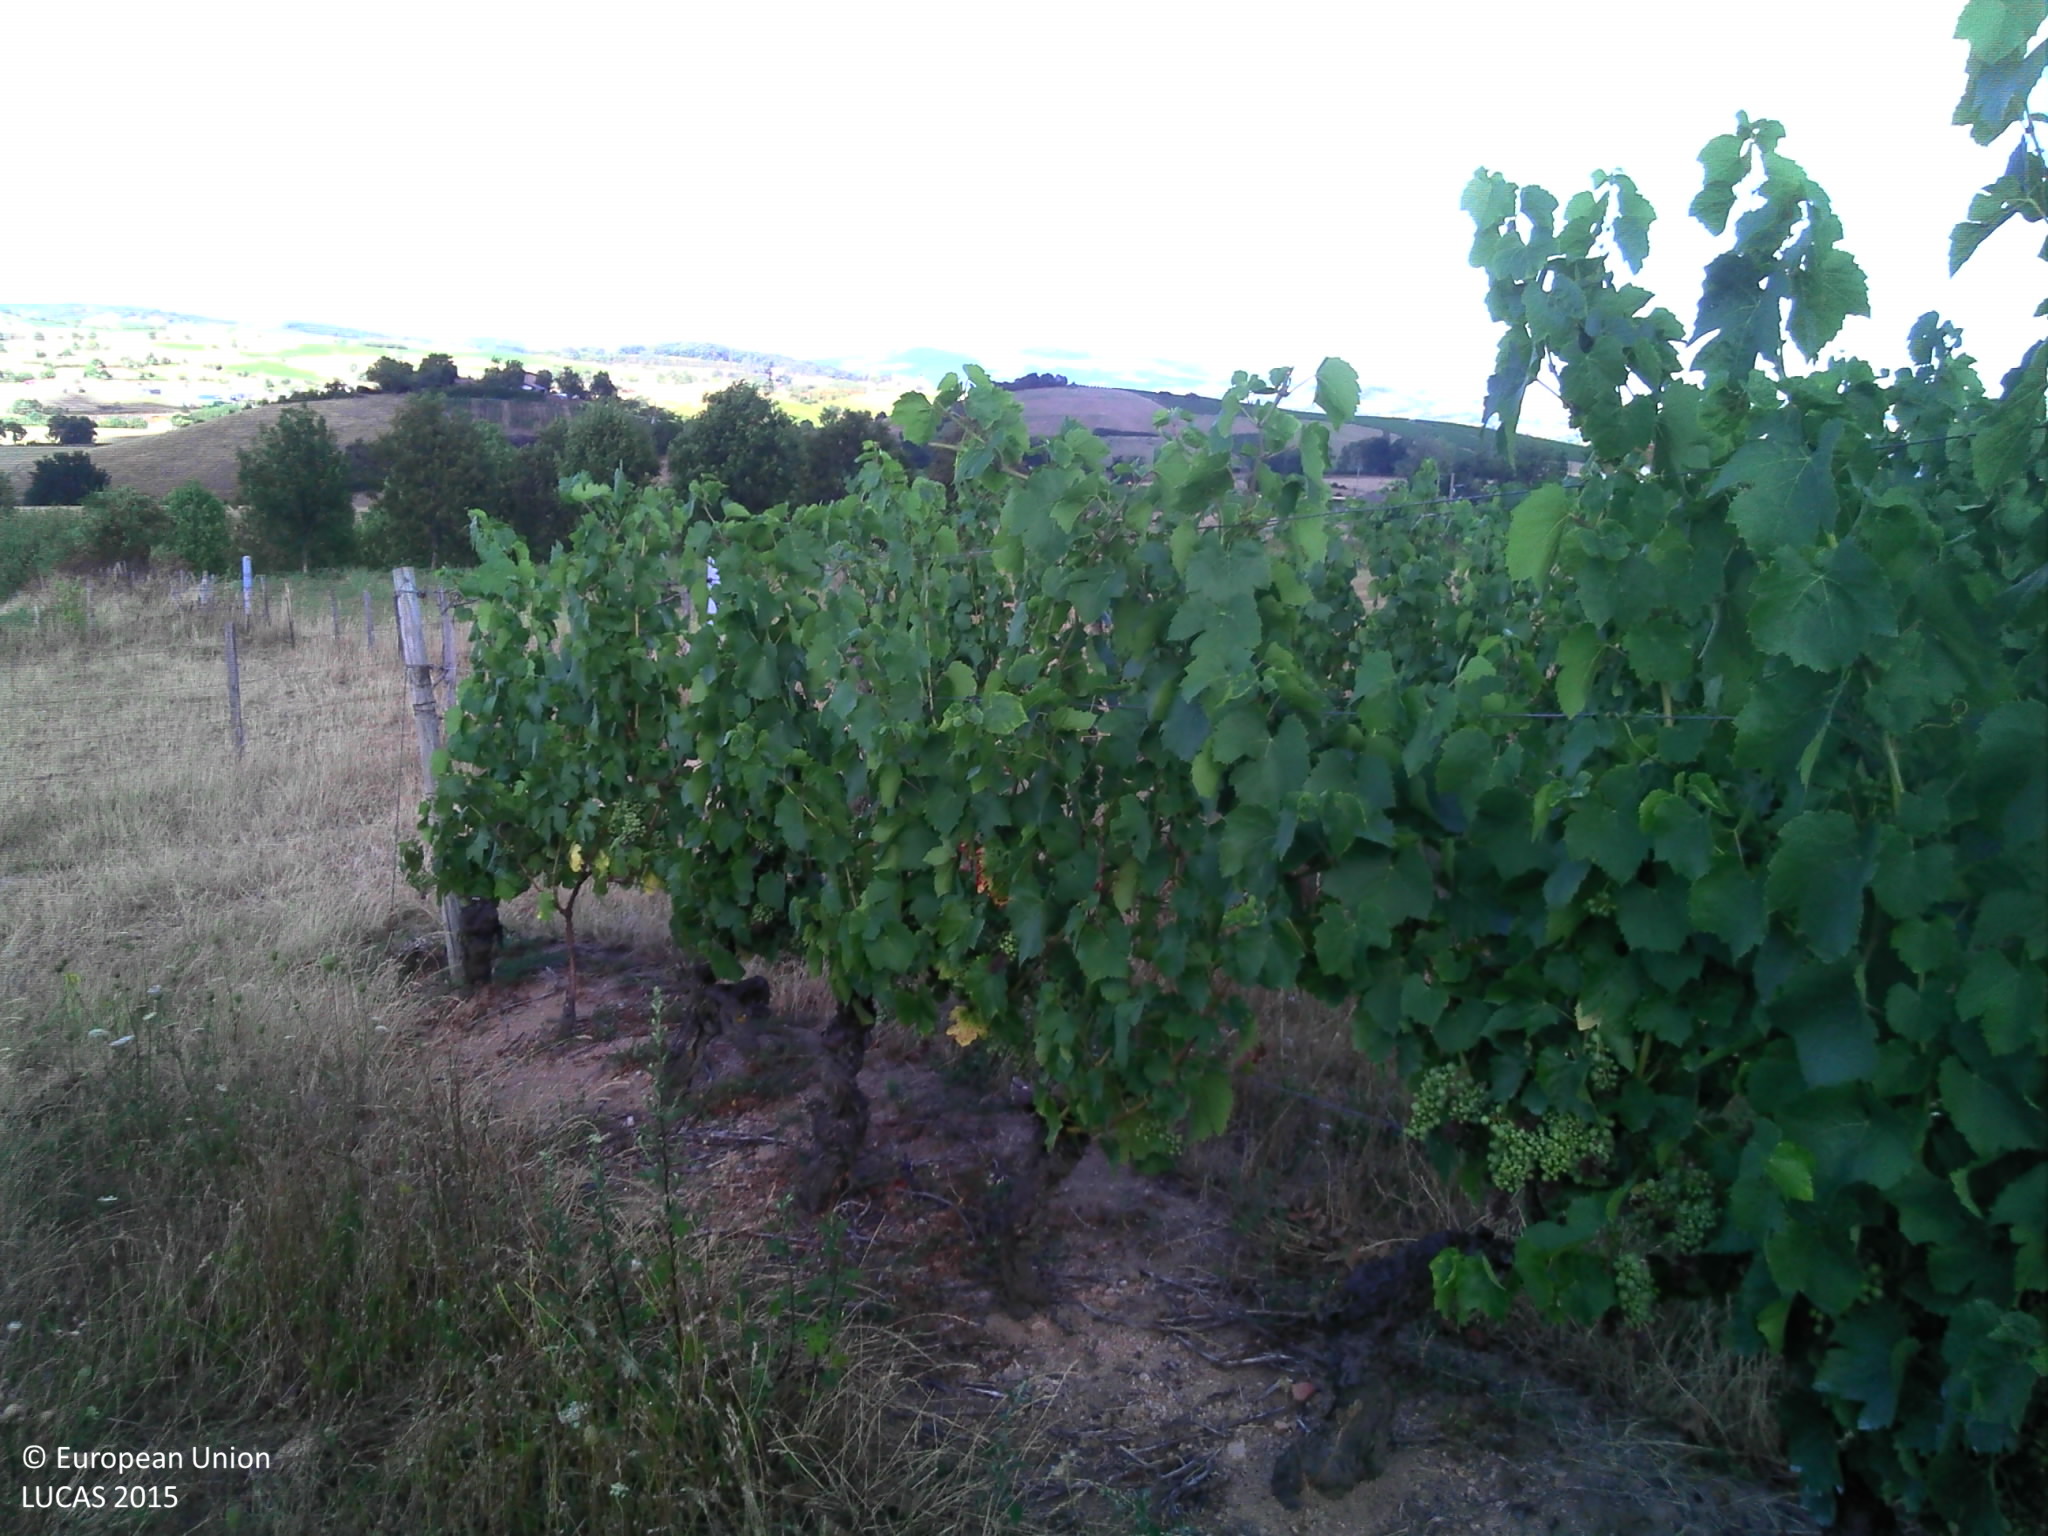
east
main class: Cropland
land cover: Vineyards
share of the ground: > 75 %
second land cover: Grassland without tree/shrub cover
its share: 10 - 25 %
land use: Agriculture (excluding fallow land and kitchen gardens)
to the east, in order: Vineyards; Grassland without tree/shrub cover; Grass margins; Fences; Grassland without tree/shrub cover; Spontaneously vegetated surfaces; Paved roads, cycling and walking lanes; Grass margins; Fences; Cherry fruit; Fences; Tracks; Cherry fruit
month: July
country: FR
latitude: 45.8502
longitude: 4.5299
